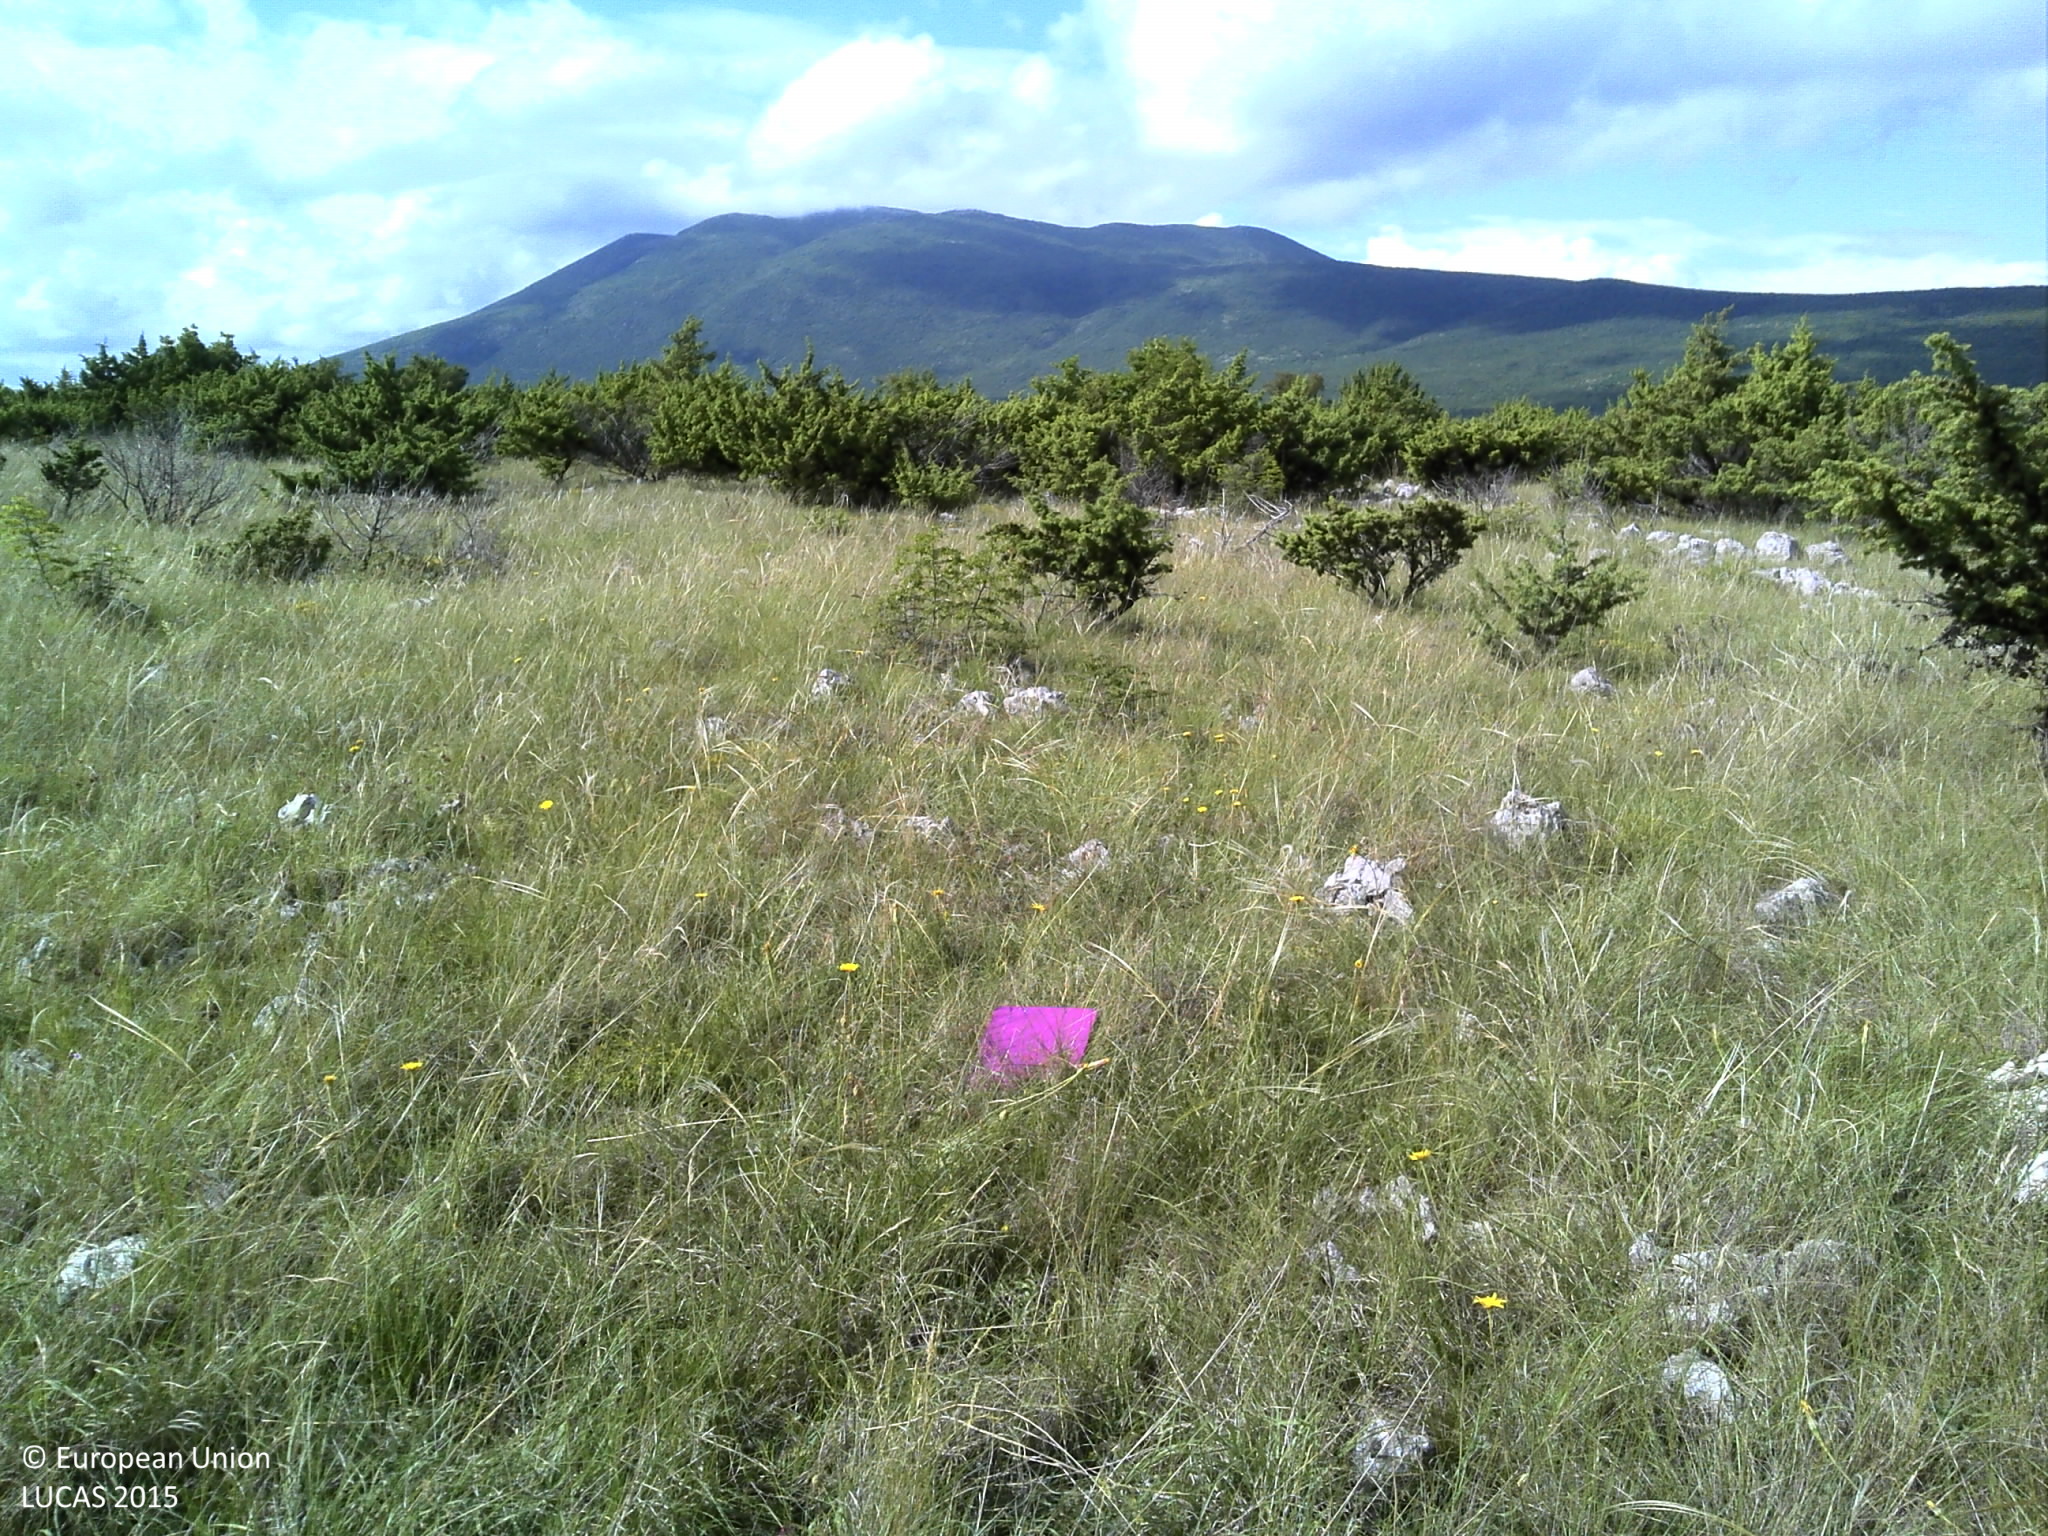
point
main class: Grassland
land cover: Grassland with sparse tree/shrub cover
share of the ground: > 75 %
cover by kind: herbaceous plants 75 %, shrubs 10 %, unconsolidated bare surface 10 %, coniferous forest trees 5 %
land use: Semi-natural and natural areas not in use
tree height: < 5 m
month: May
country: HR
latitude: 43.9849
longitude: 16.1888
